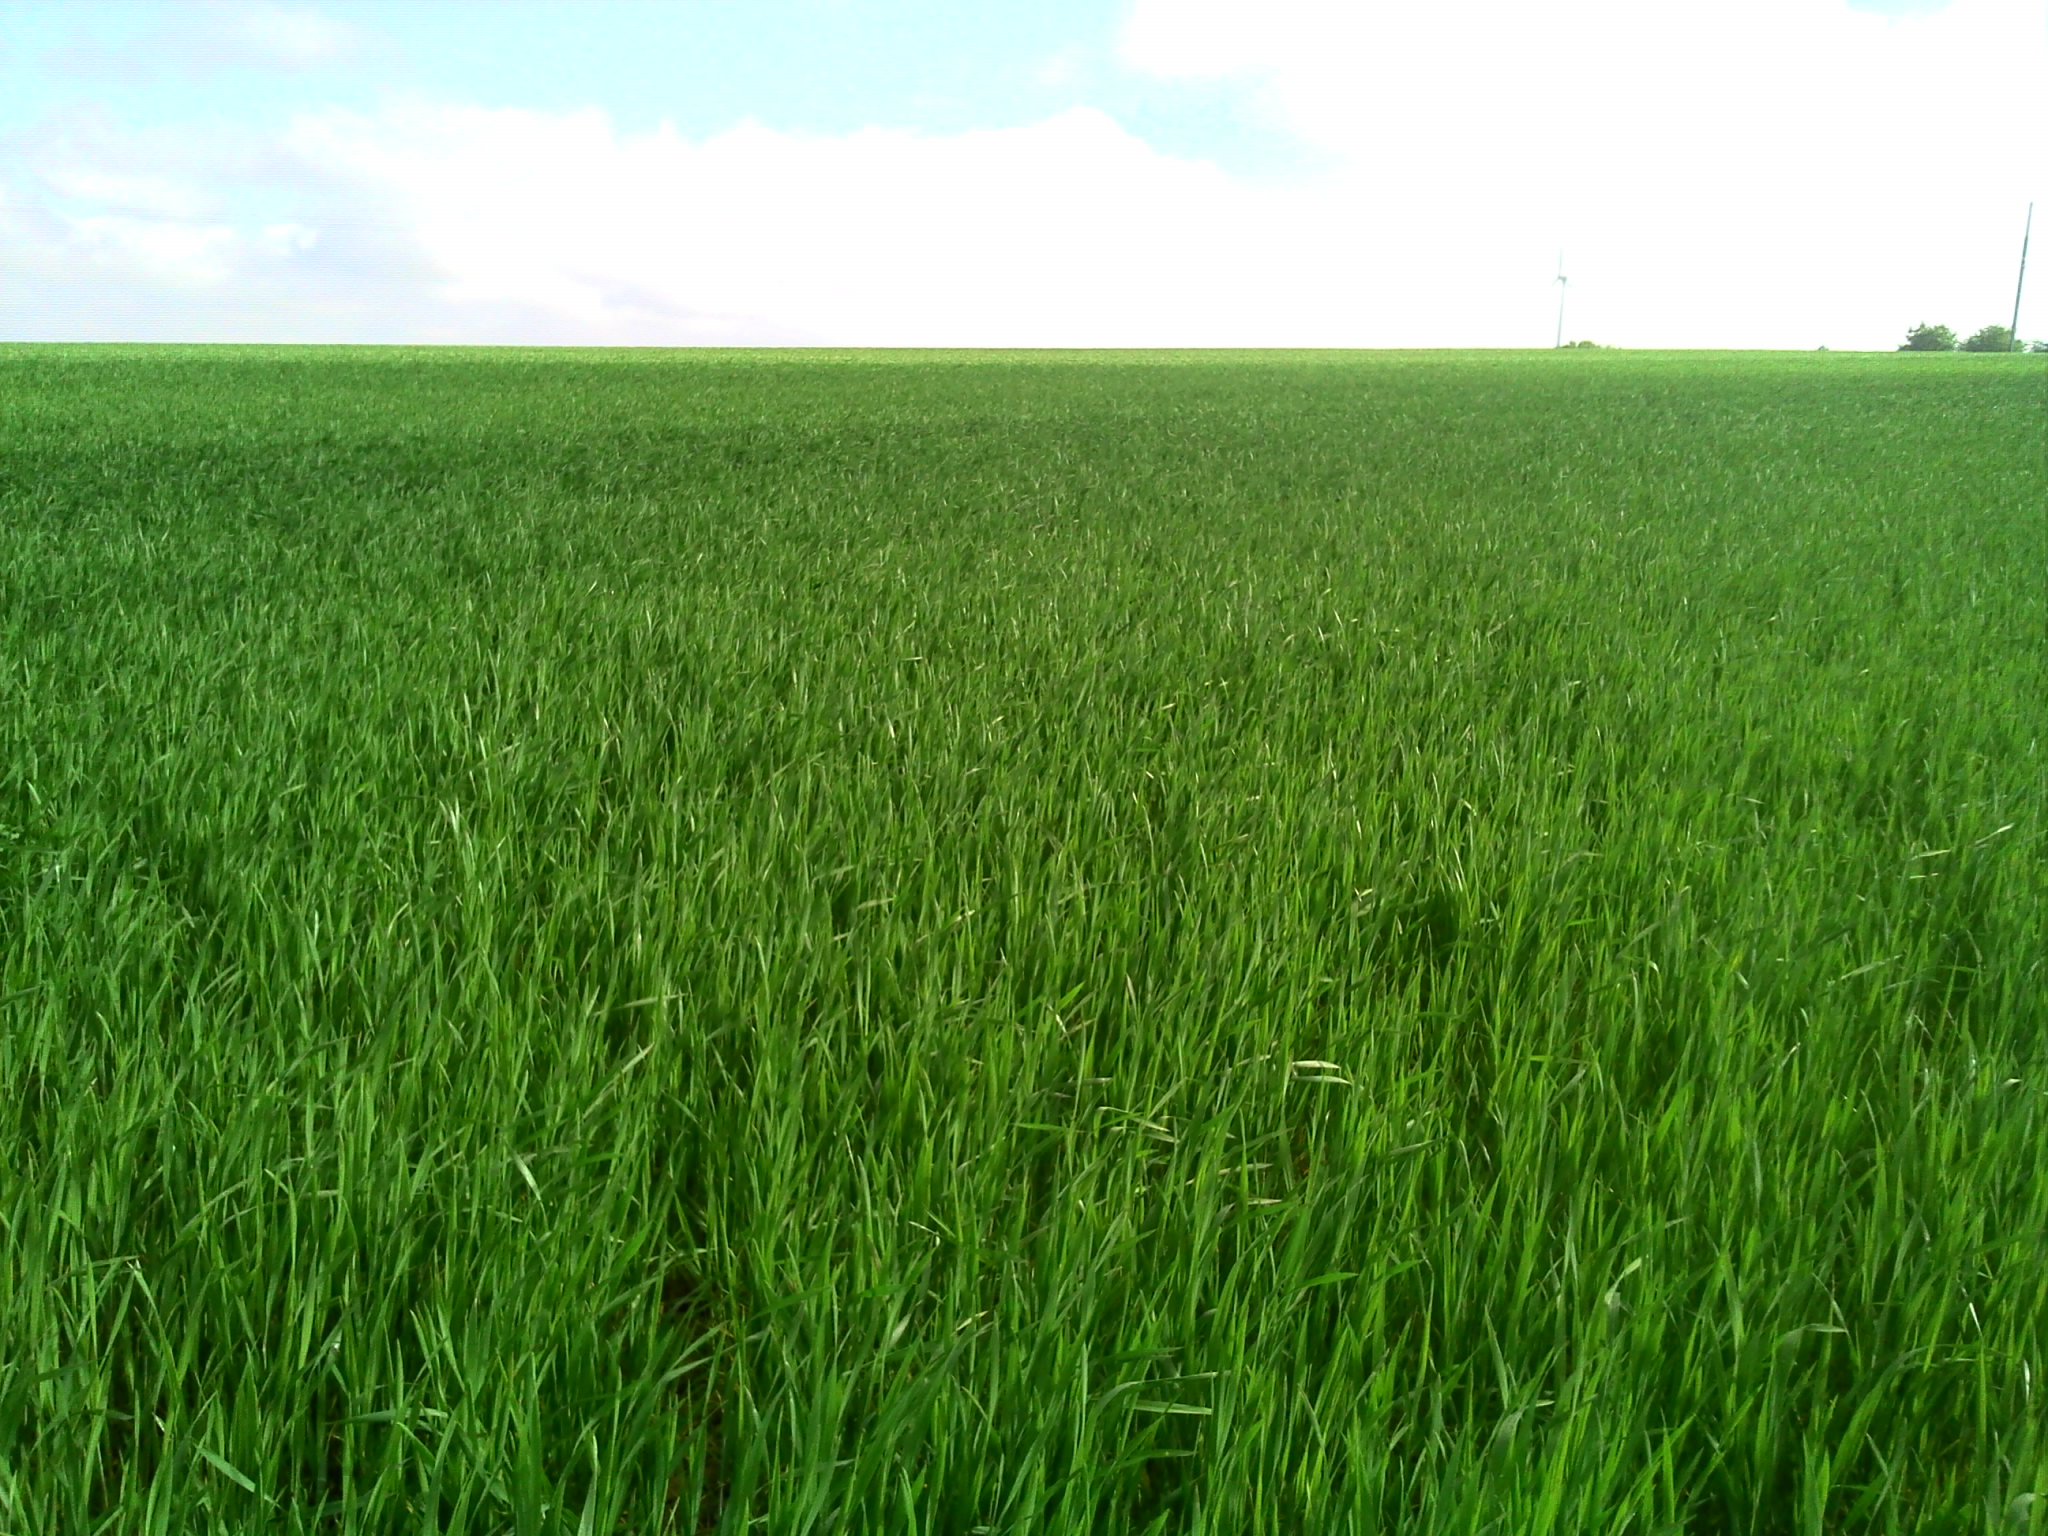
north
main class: Cropland
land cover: Common wheat
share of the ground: > 75 %
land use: Agriculture (excluding fallow land and kitchen gardens)
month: May
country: LU
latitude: 50.0199
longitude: 5.8817
